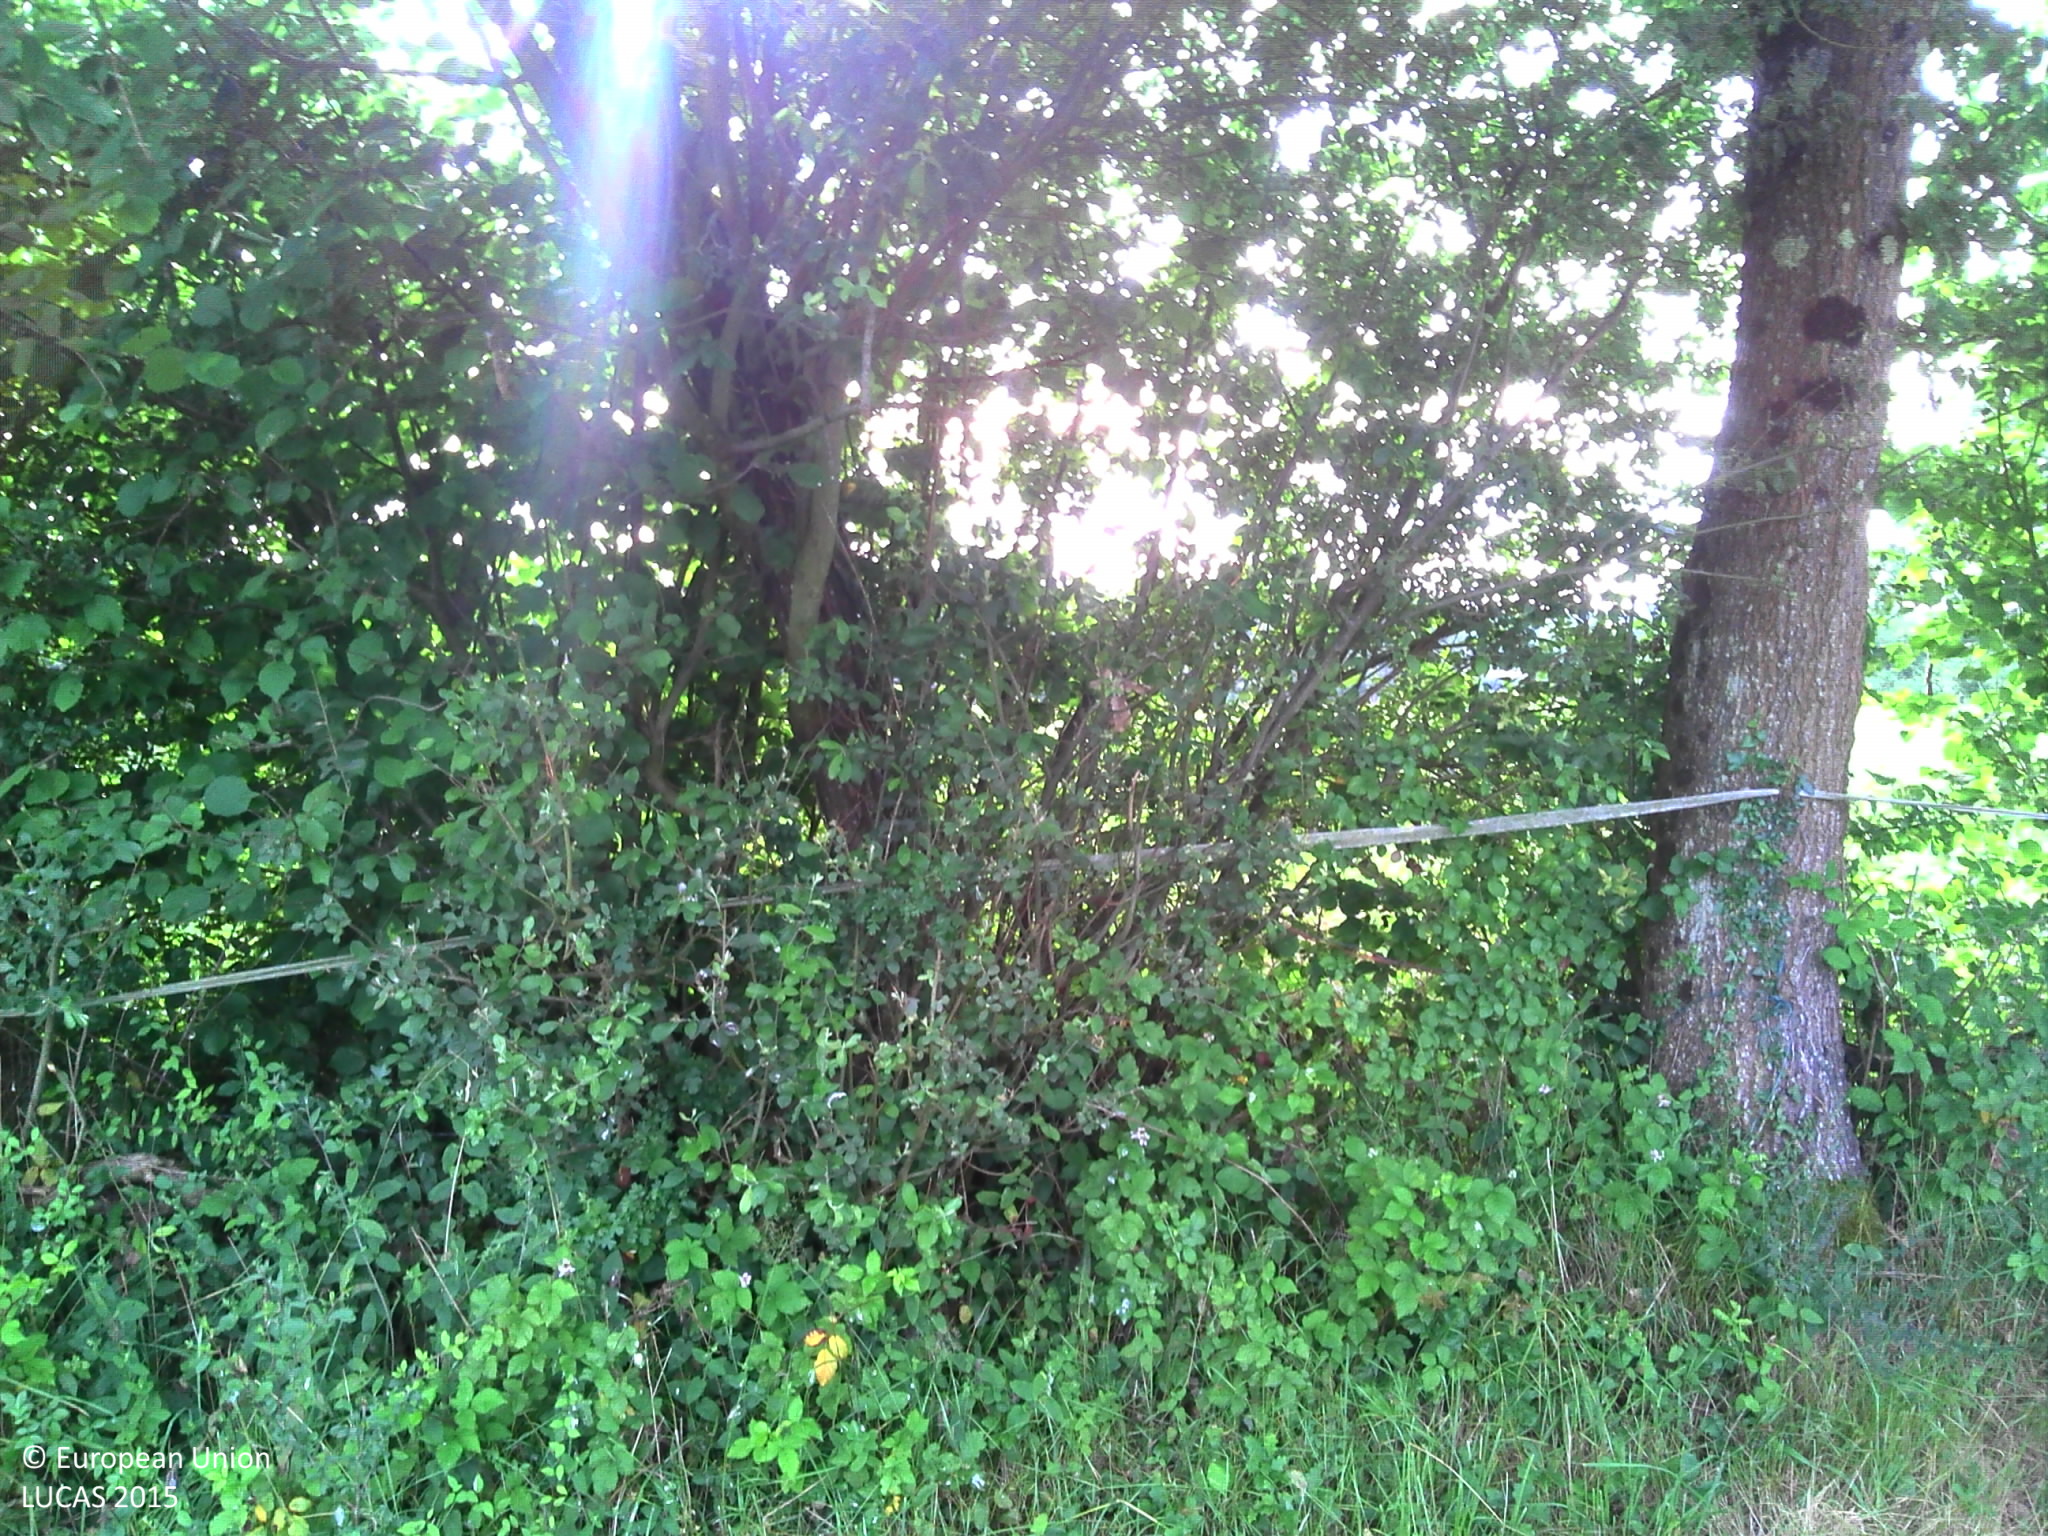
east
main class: Woodland
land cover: Broadleaved woodland
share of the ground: > 75 %
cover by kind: broadleaved forest trees 50 %, shrubs 40 %, herbaceous plants 10 %
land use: Agriculture (excluding fallow land and kitchen gardens)
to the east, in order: Broadleaved woodland; Fences; Broadleaved woodland; Ditches and canals; Clovers; Broadleaved woodland; Clovers; Temporary grasslands; Clovers; Temporary grasslands; Pine dominated coniferous woodland; Grassland without tree/shrub cover
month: June
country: FR
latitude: 47.3216
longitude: -1.5666
